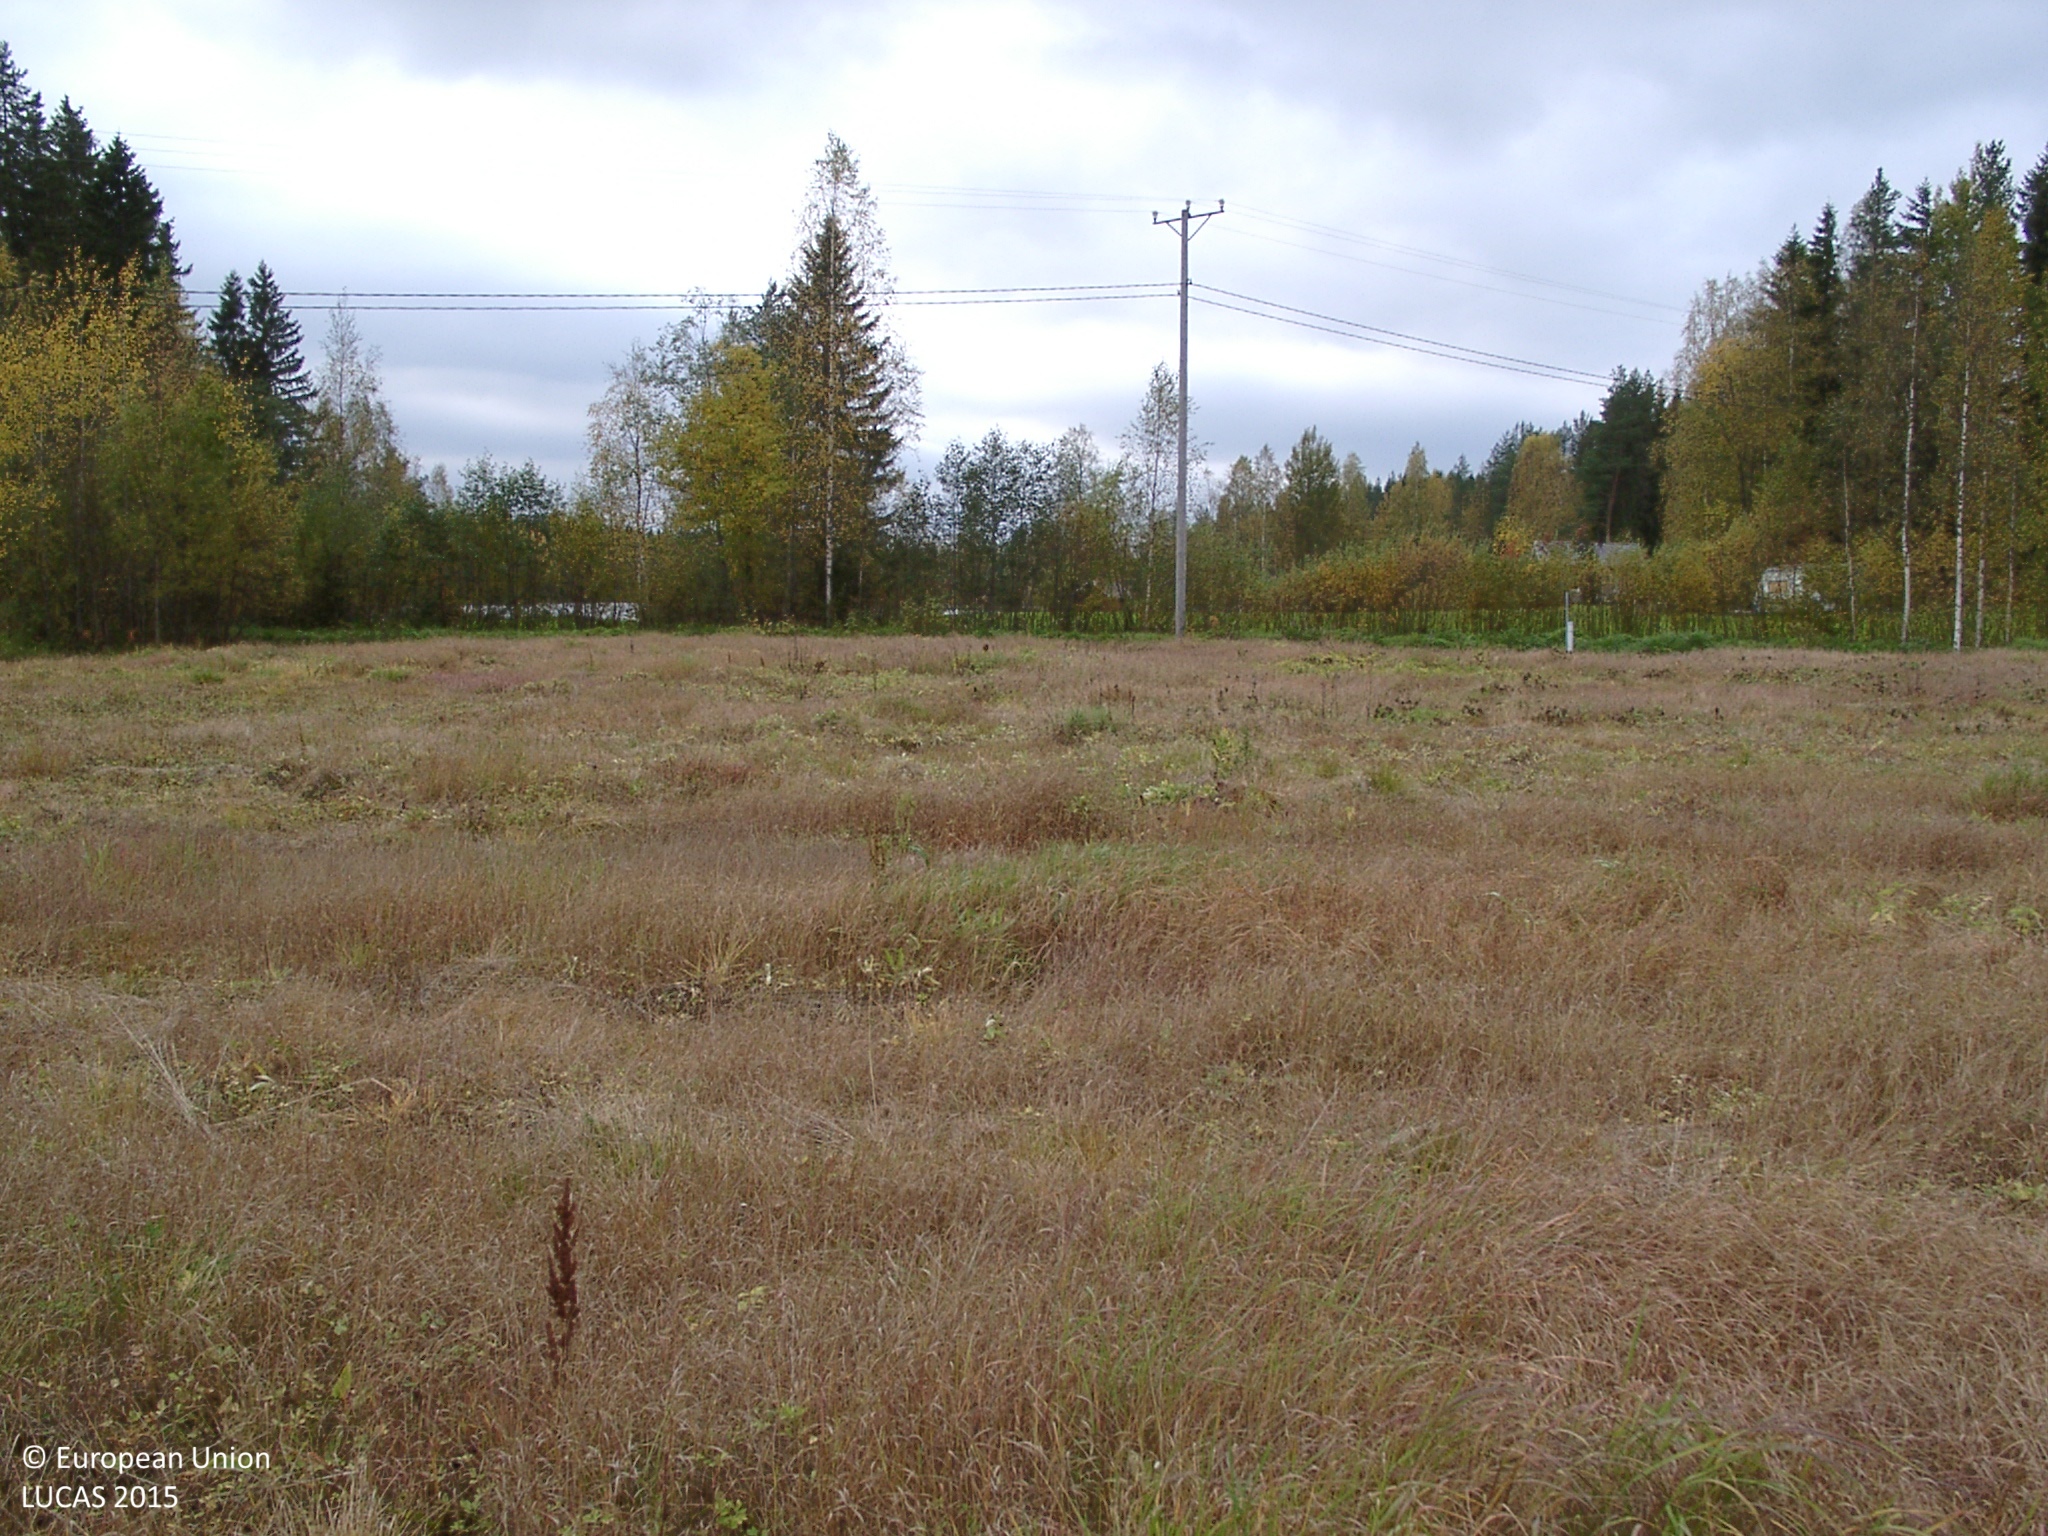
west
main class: Grassland
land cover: Spontaneously vegetated surfaces
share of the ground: > 75 %
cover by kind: herbaceous plants 100 %
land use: Fallow land
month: September
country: FI
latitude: 62.6000
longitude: 25.2788
